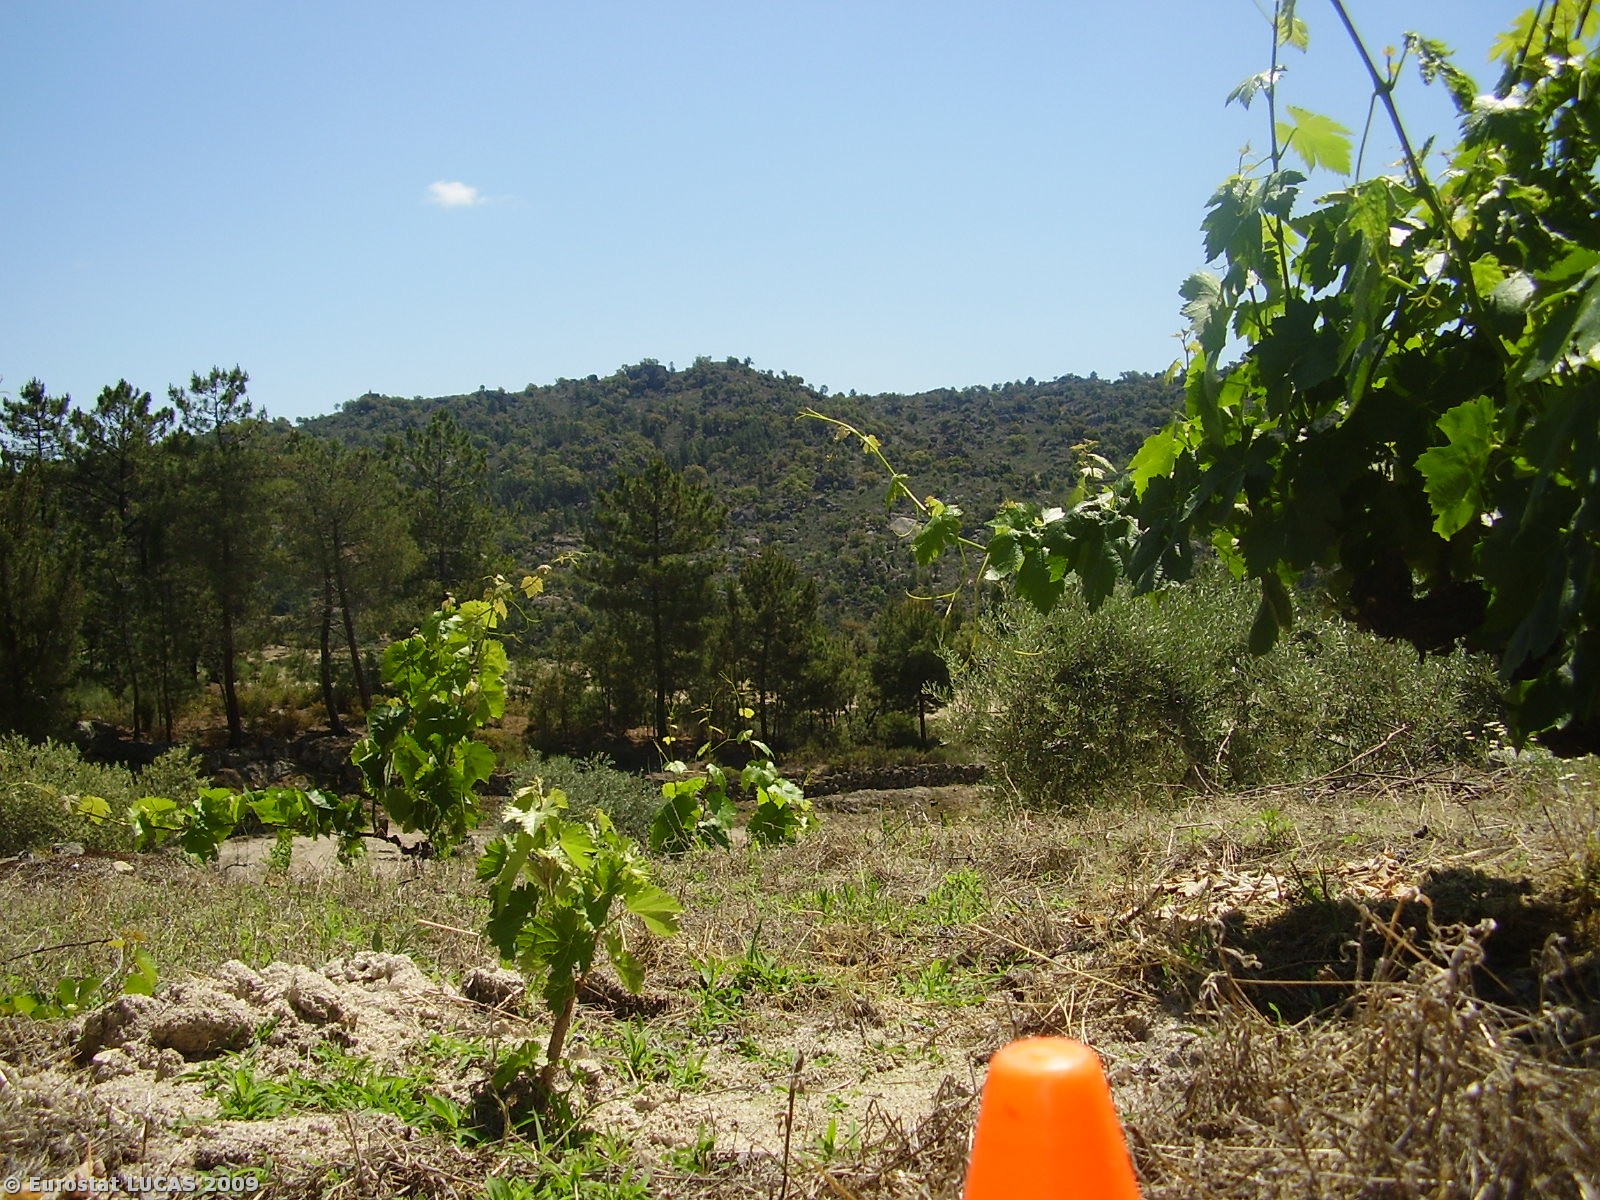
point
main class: Cropland
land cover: Vineyards
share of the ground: < 10 %
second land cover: Olive groves
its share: < 10 %
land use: Agriculture (excluding fallow land and kitchen gardens)
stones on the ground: < 10 %
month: May
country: PT
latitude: 41.3069
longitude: -7.2577
